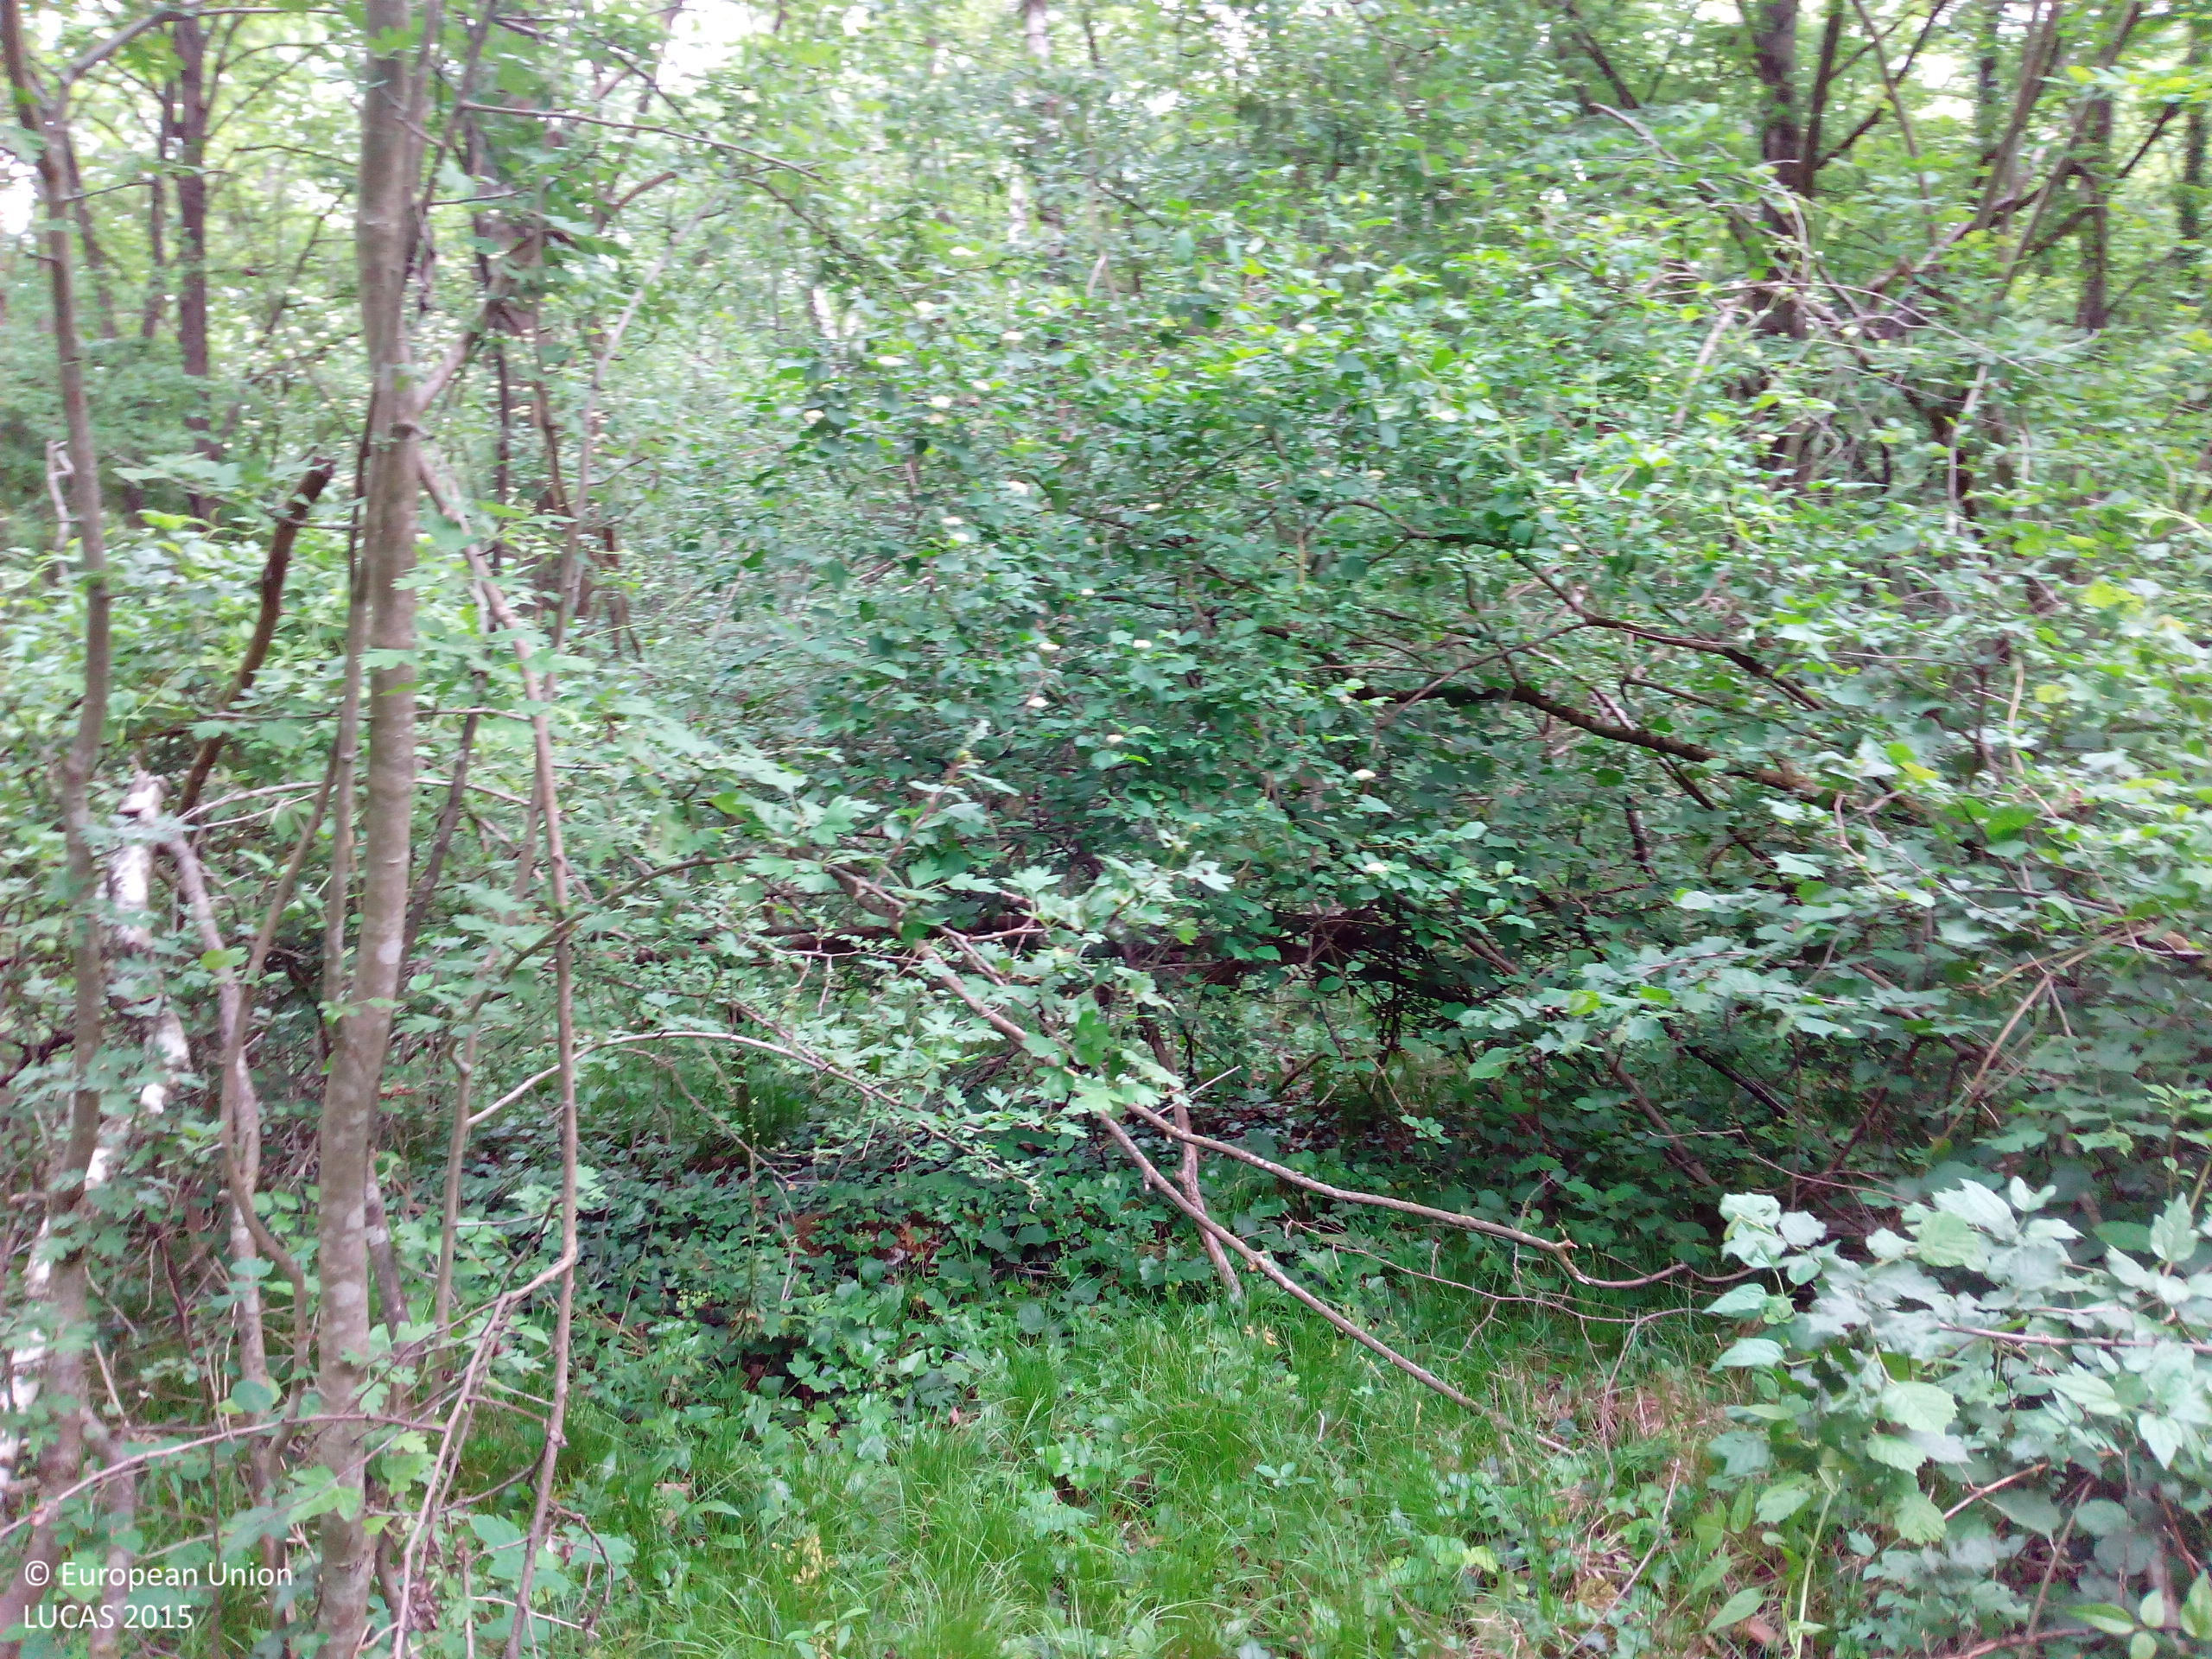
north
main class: Woodland
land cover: Broadleaved woodland
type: floodplain forest
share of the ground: > 75 %
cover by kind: broadleaved forest trees 85 %, shrubs 10 %, herbaceous plants 5 %
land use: Forestry
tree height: > 5 m
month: May
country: DE
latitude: 47.9641
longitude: 7.6306
